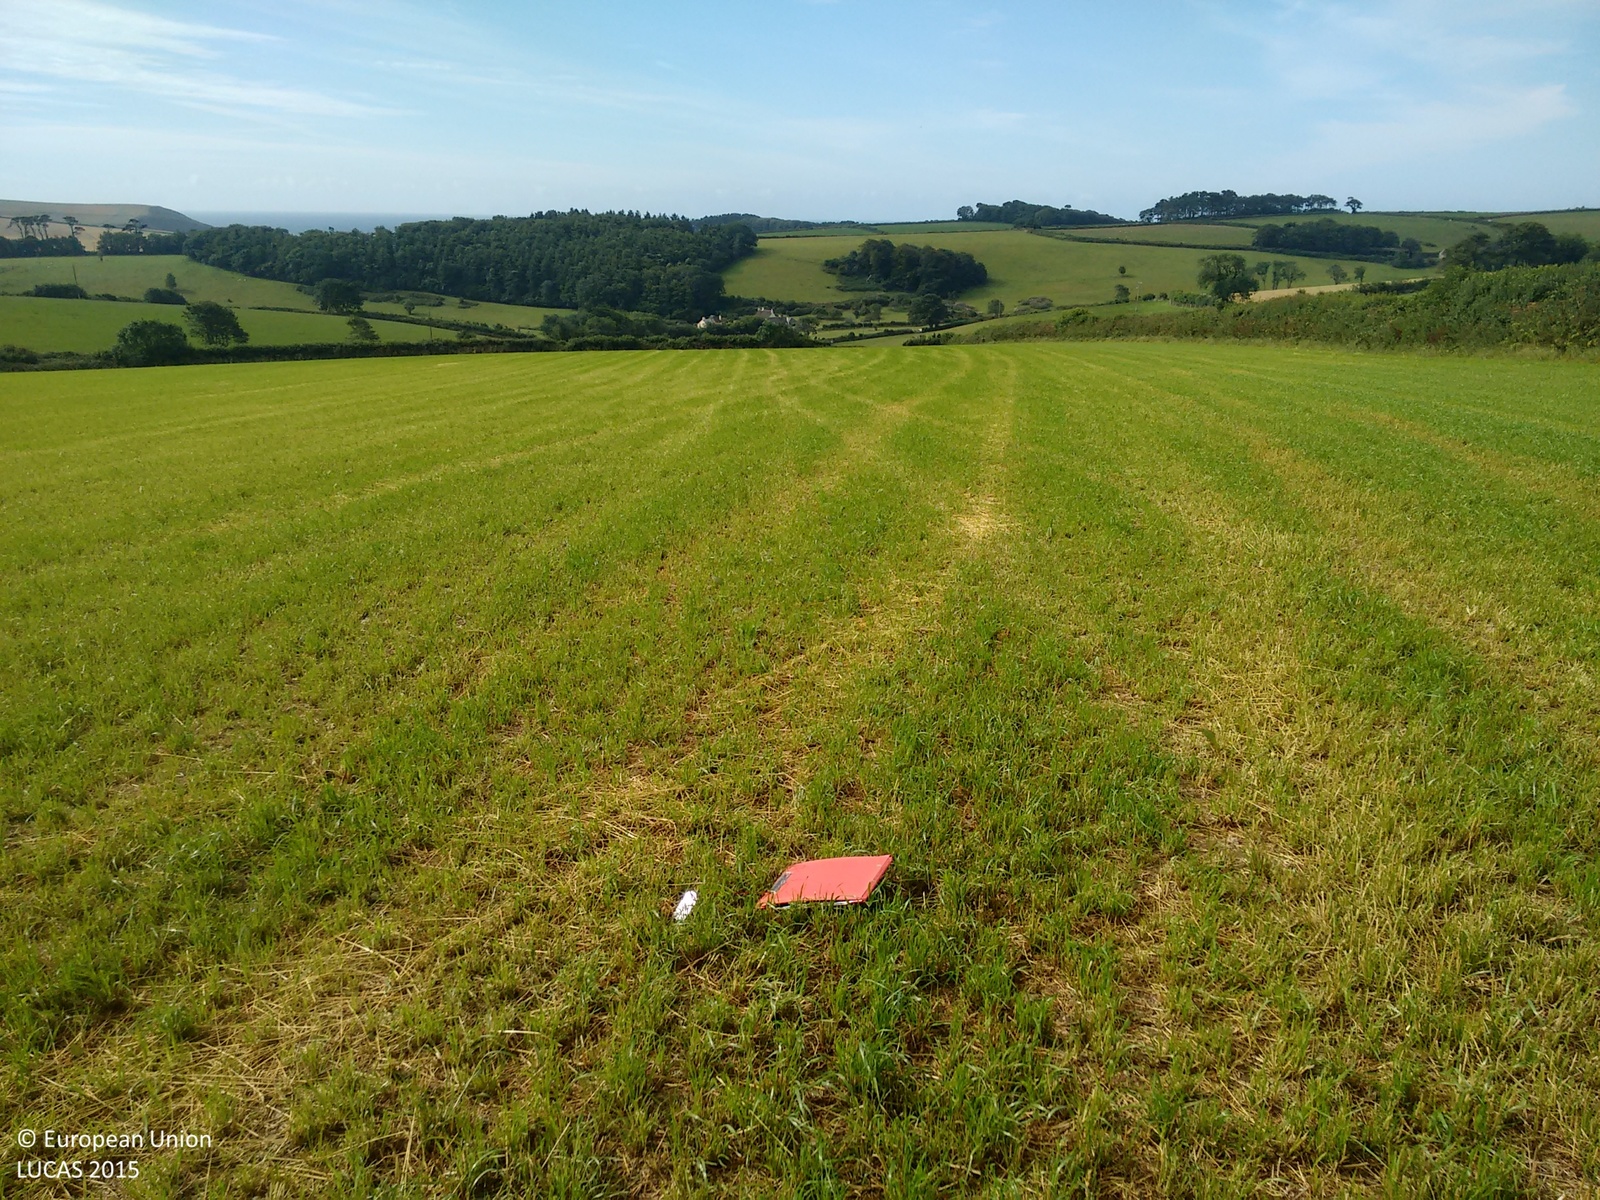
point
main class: Cropland
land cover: Temporary grasslands
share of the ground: > 75 %
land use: Agriculture (excluding fallow land and kitchen gardens)
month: August
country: GB
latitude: 50.3244
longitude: -3.9561
